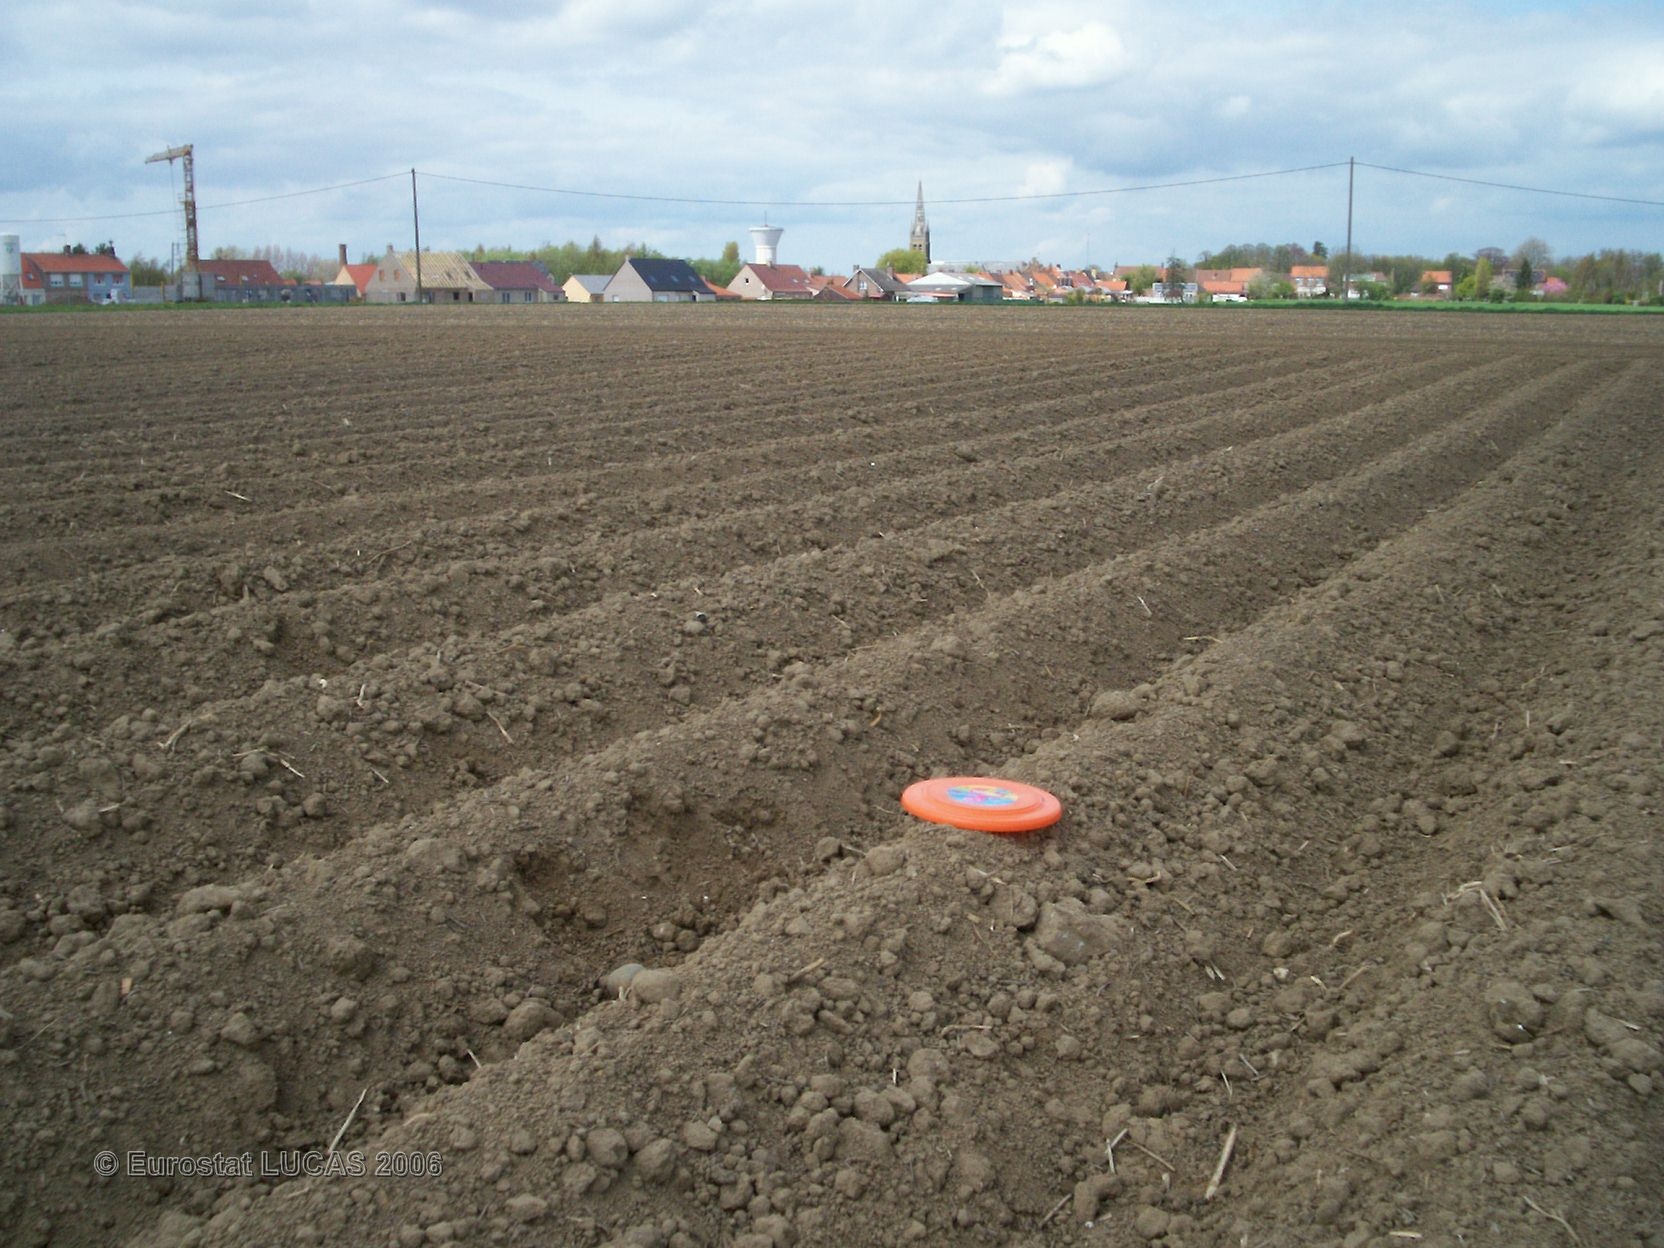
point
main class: Cropland
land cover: Potatoes
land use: Agriculture (excluding fallow land and kitchen gardens)
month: May
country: FR
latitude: 50.9333
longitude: 2.5456
